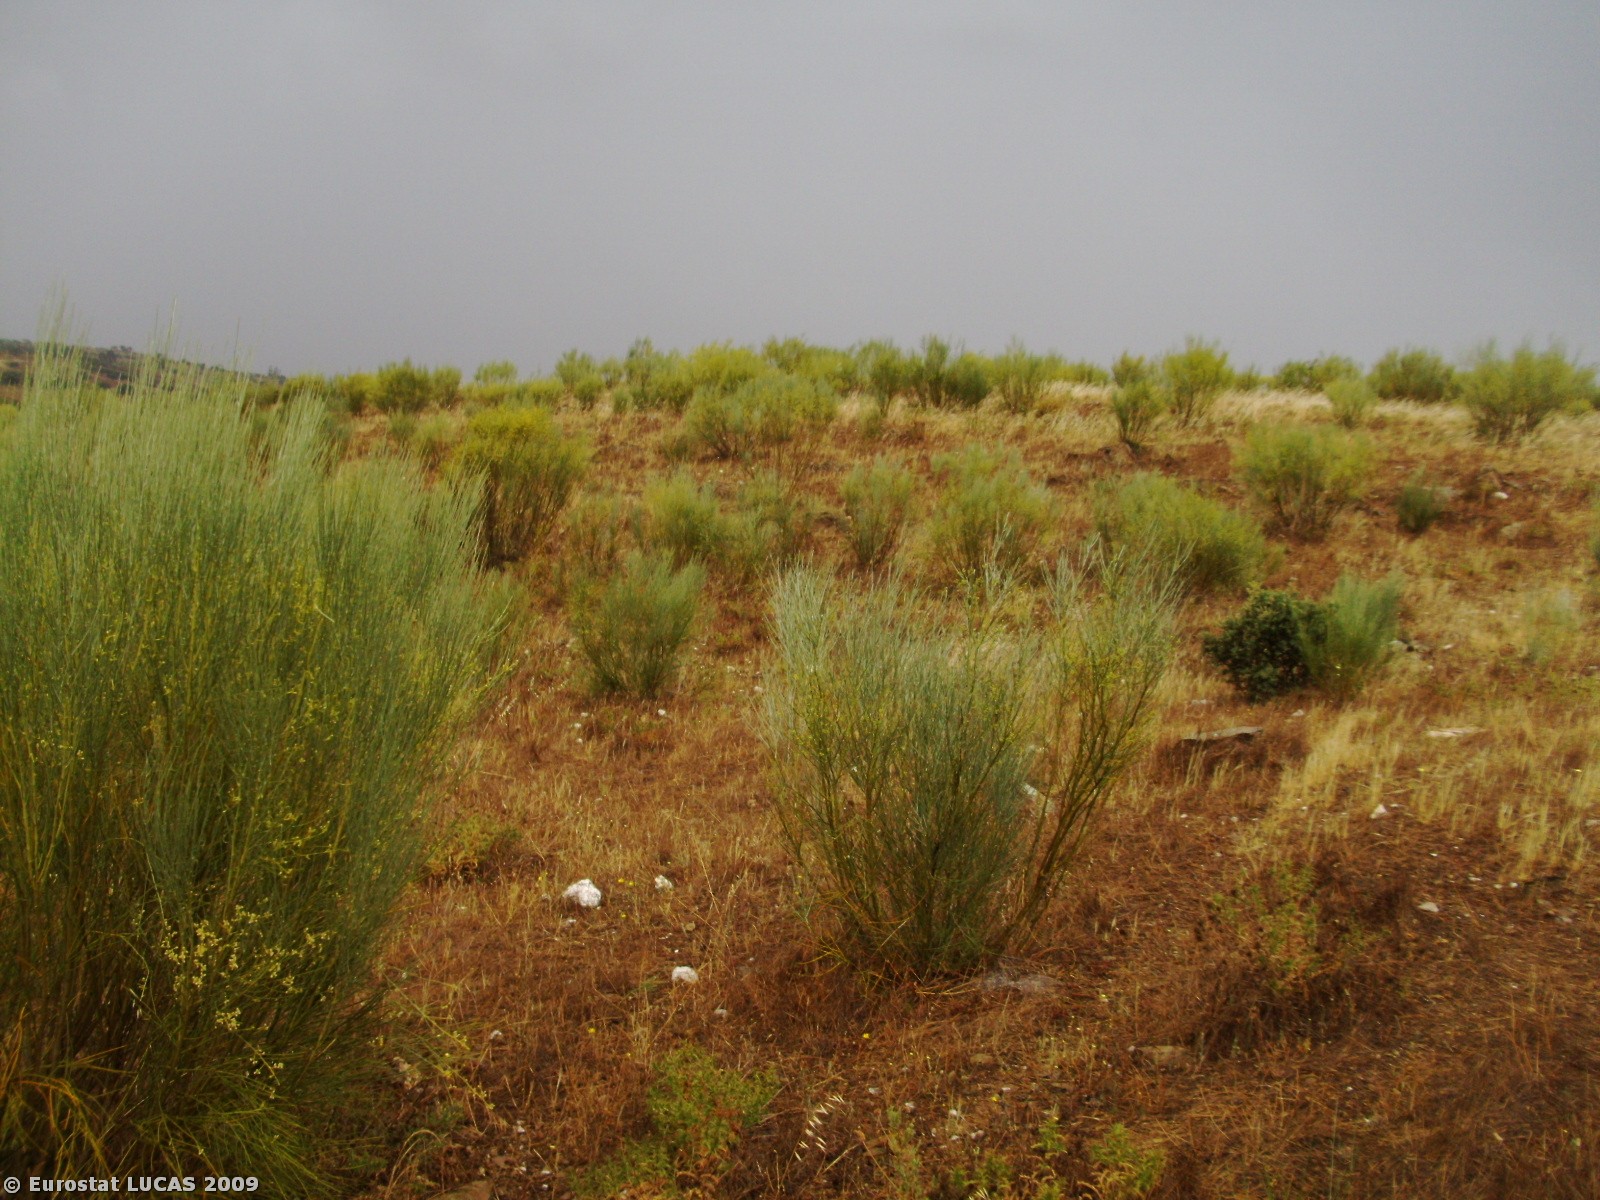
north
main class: Shrubland
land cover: Shrubland without tree cover
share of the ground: > 75 %
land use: Unused
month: June
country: PT
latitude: 39.7385
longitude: -7.1612
